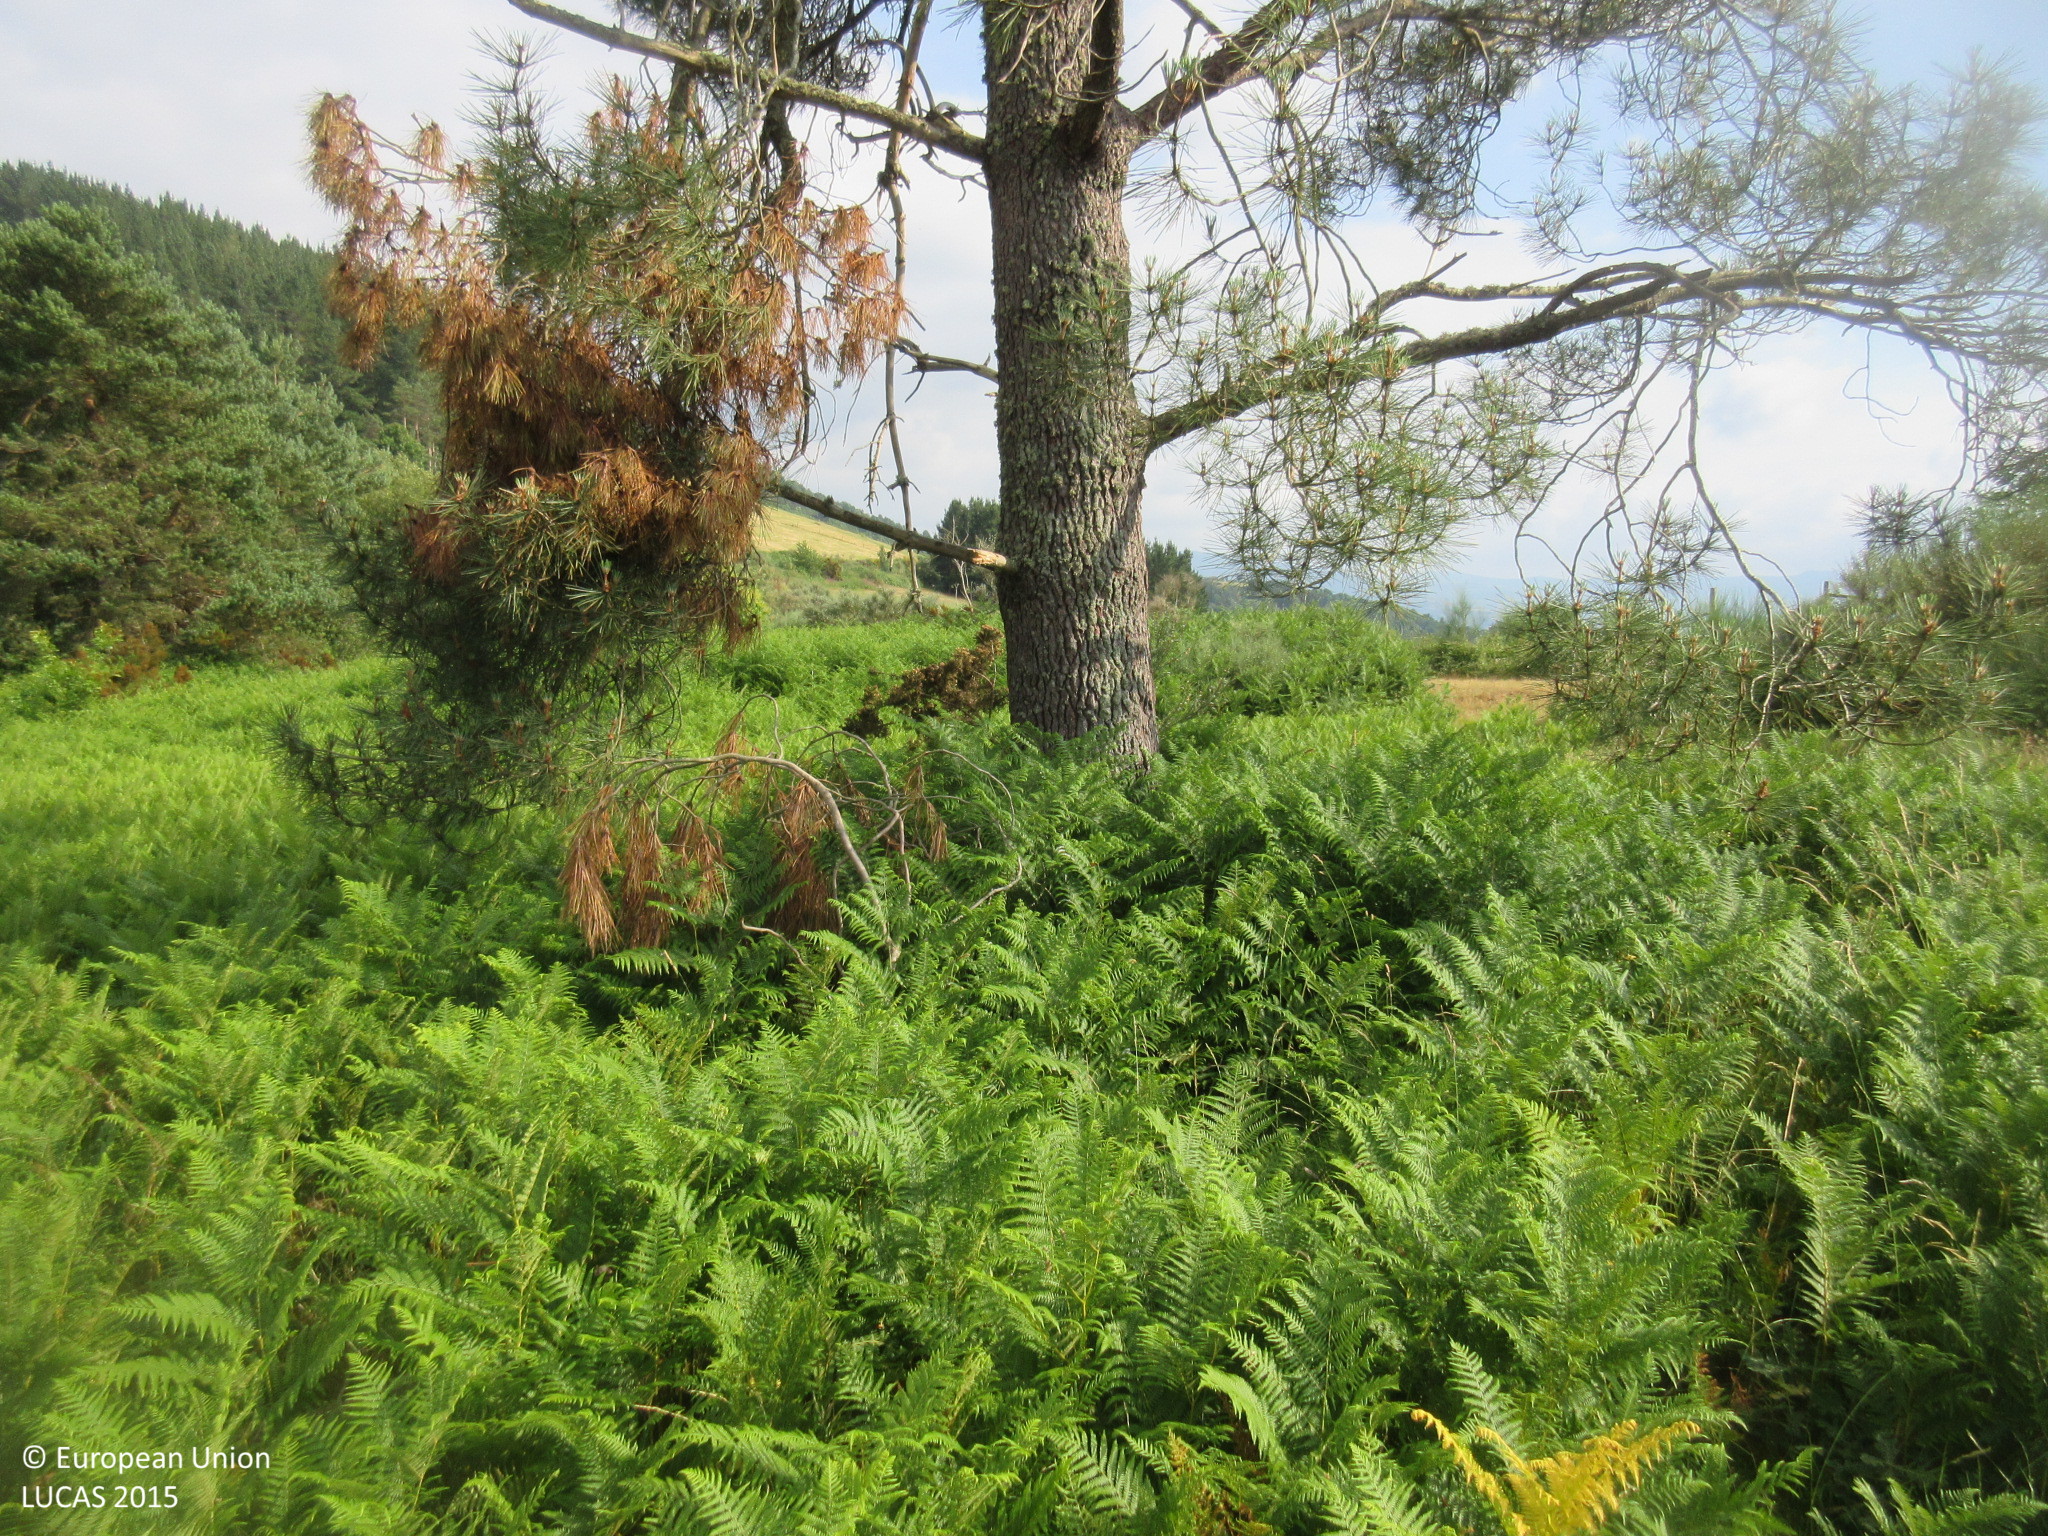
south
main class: Grassland
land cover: Grassland with sparse tree/shrub cover
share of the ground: > 75 %
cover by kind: herbaceous plants 95 %, coniferous forest trees 5 %
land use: Semi-natural and natural areas not in use
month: June
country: ES
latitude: 42.8433
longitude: -7.1073
